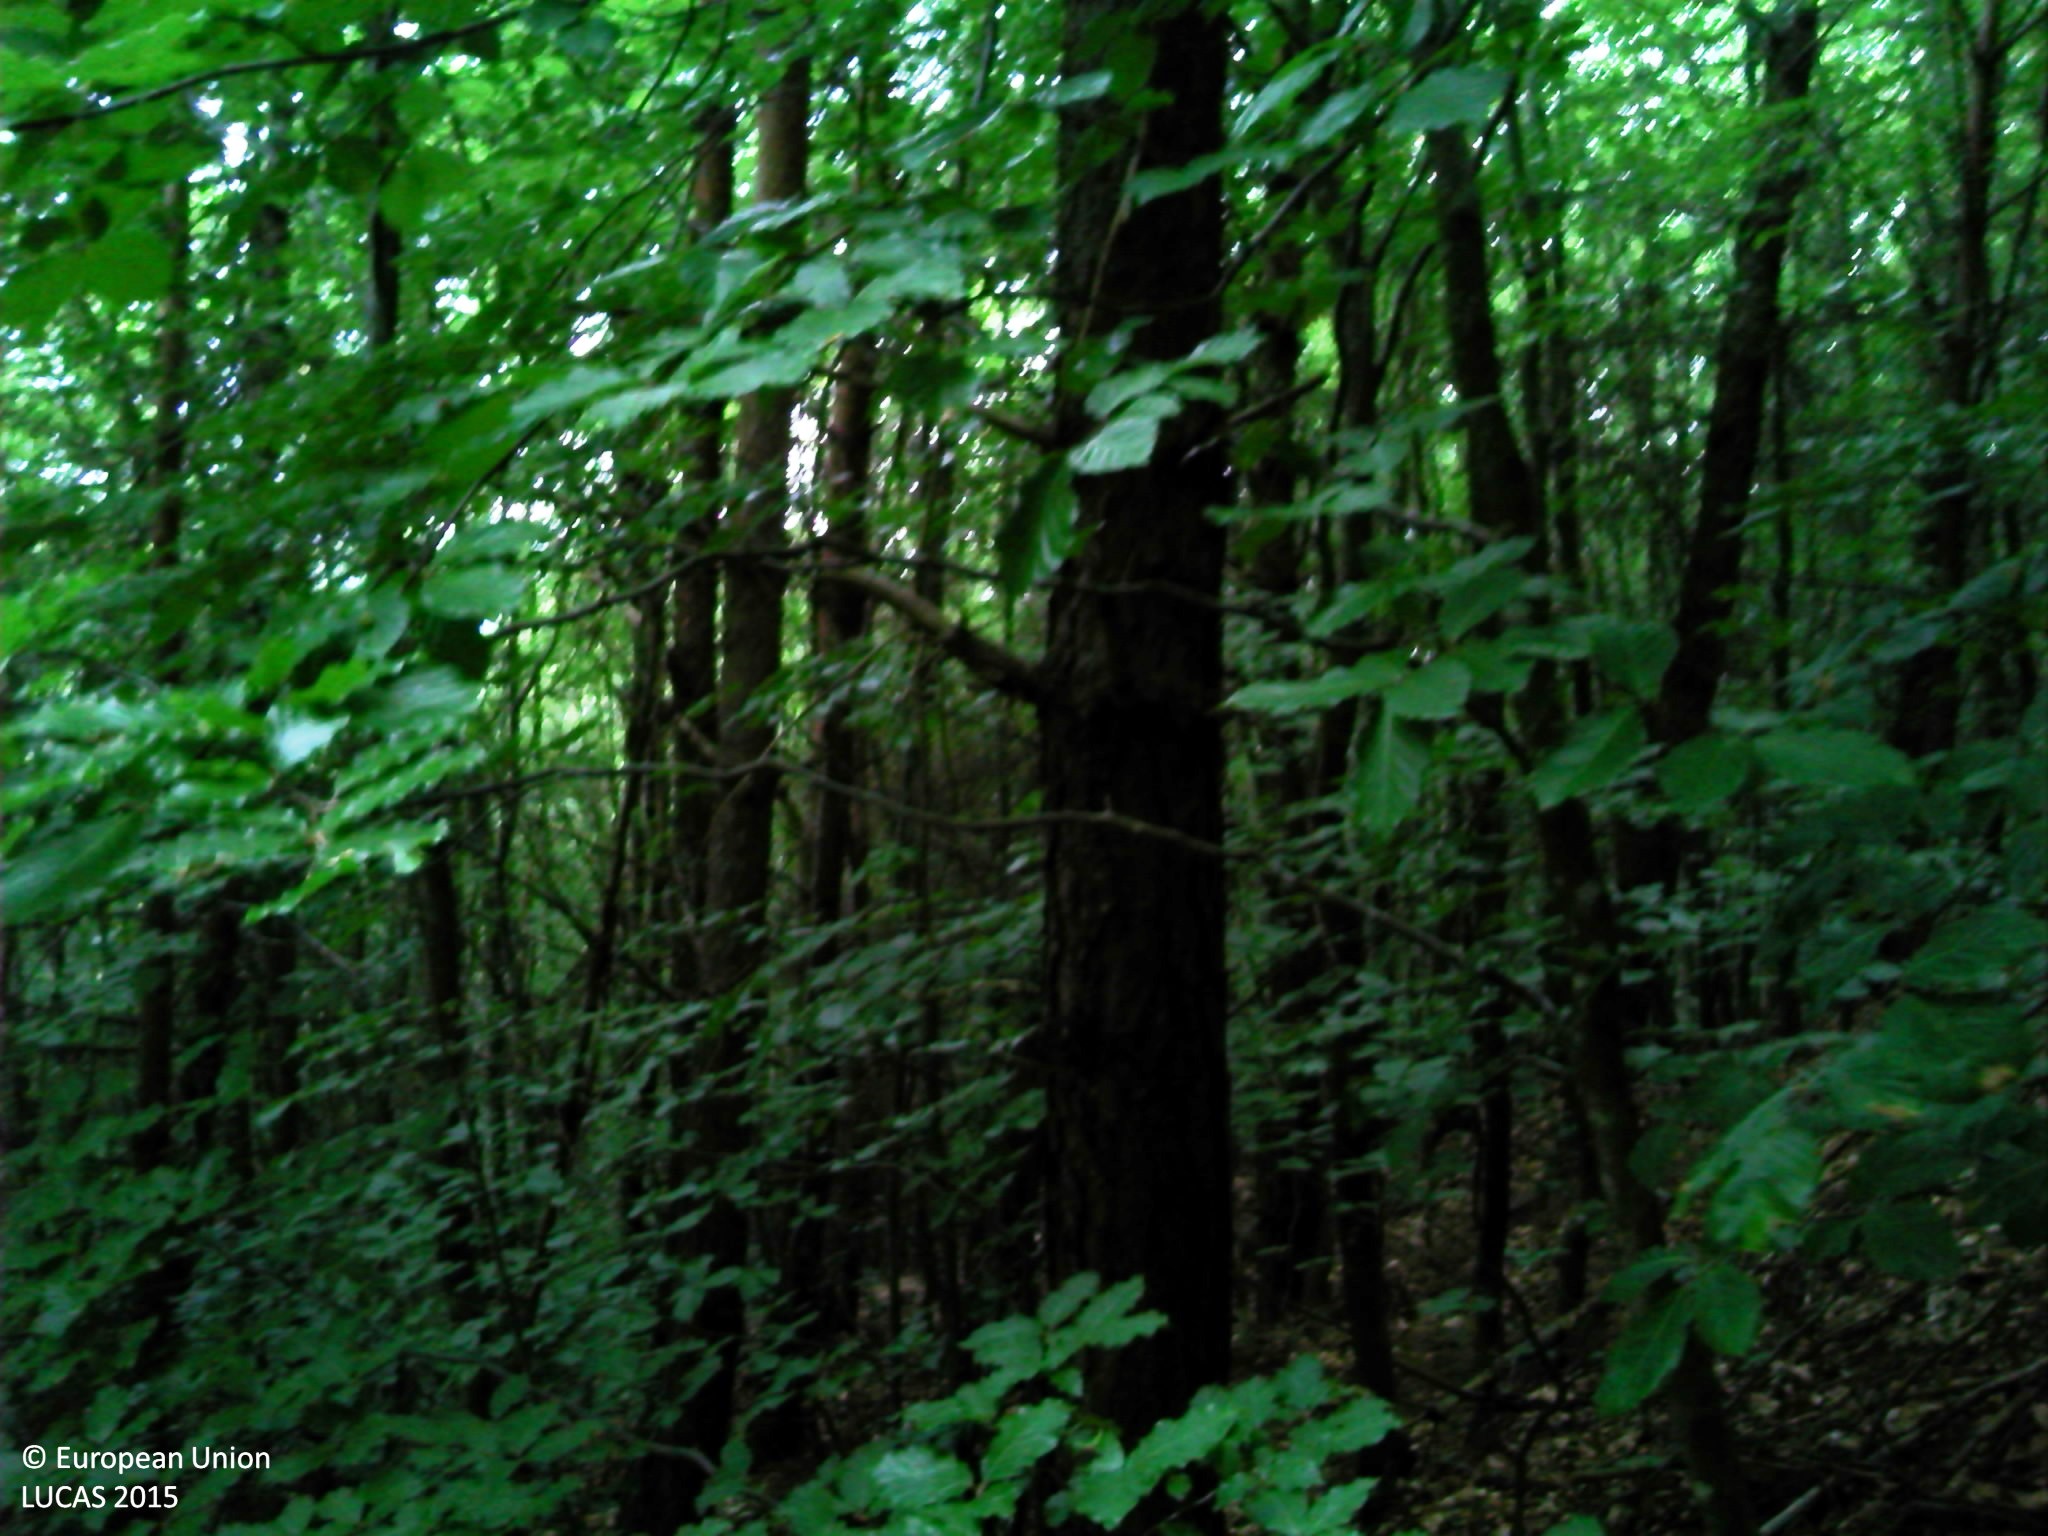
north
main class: Woodland
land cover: Broadleaved woodland
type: beech forest
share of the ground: > 75 %
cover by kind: broadleaved forest trees 75 %, coniferous forest trees 15 %, shrubs 5 %, herbaceous plants 5 %
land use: Forestry
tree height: > 5 m
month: June
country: FR
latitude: 49.0453
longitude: 7.6885
